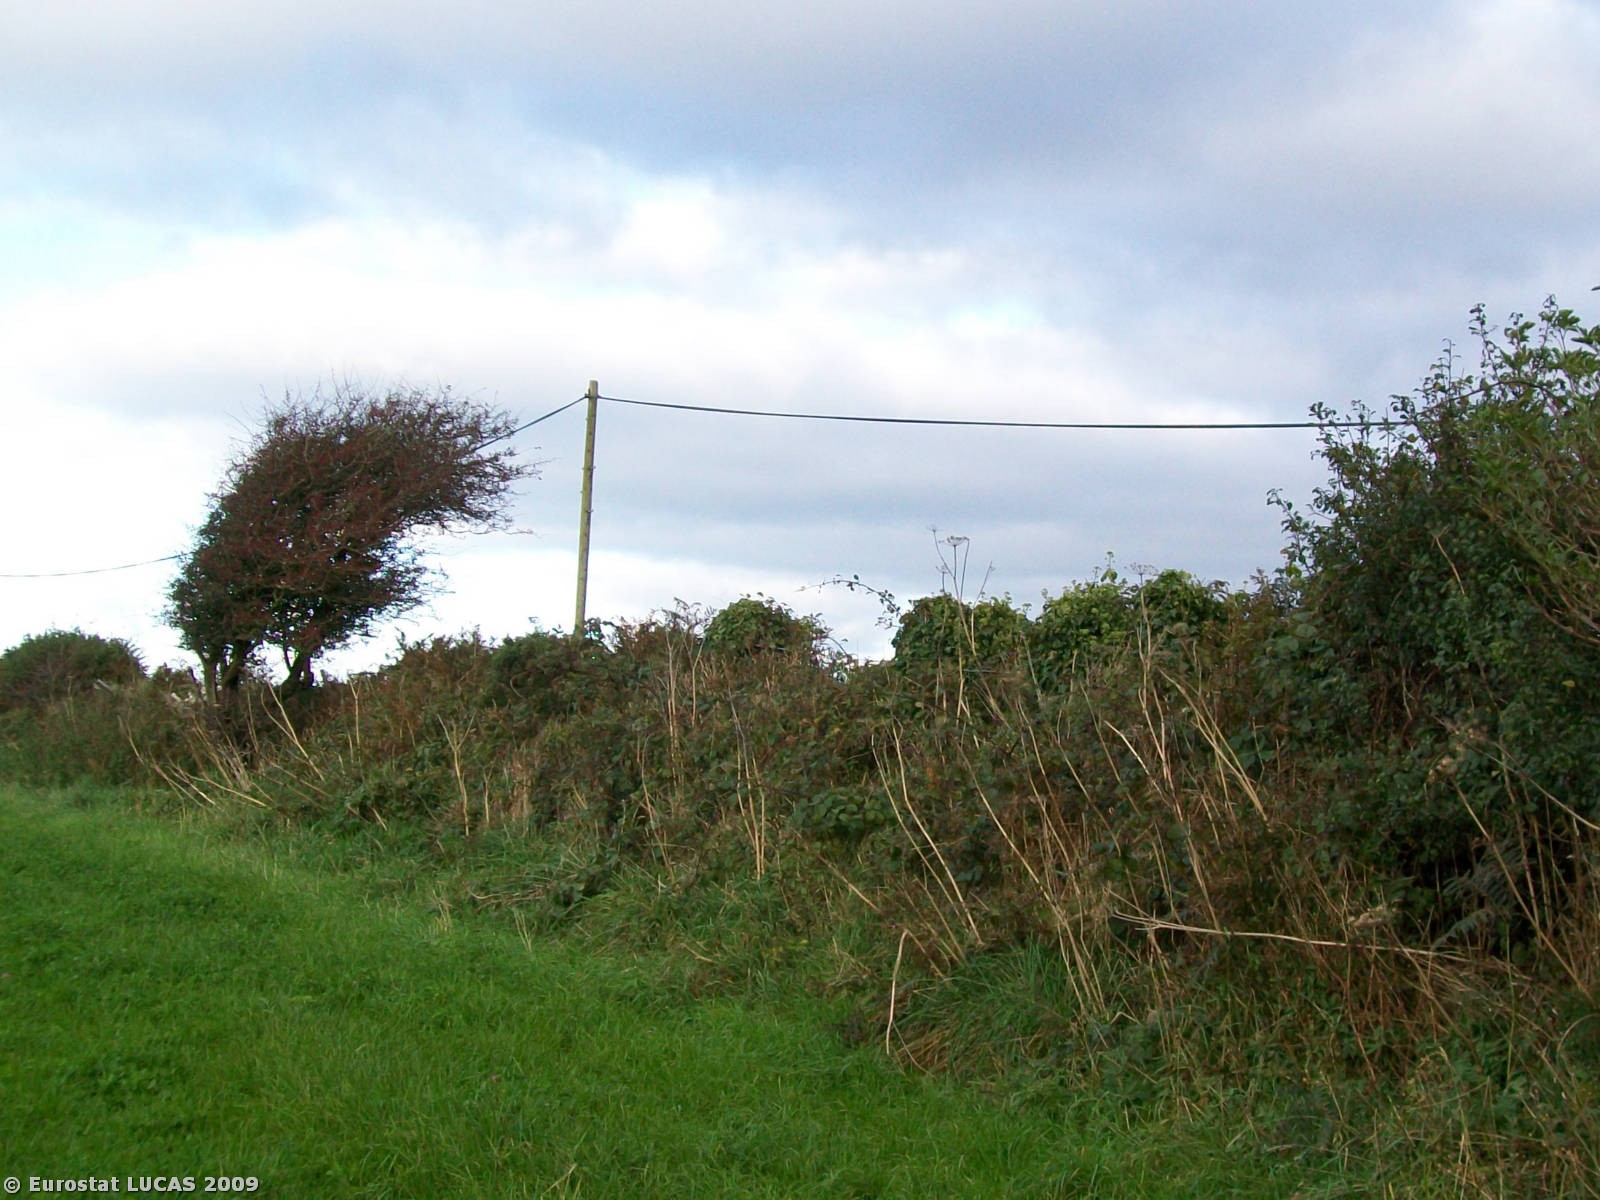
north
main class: Grassland
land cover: Grassland without tree/shrub cover
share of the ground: > 75 %
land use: Agriculture (excluding fallow land and kitchen gardens)
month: September
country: GB
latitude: 51.9613
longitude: -5.0351
